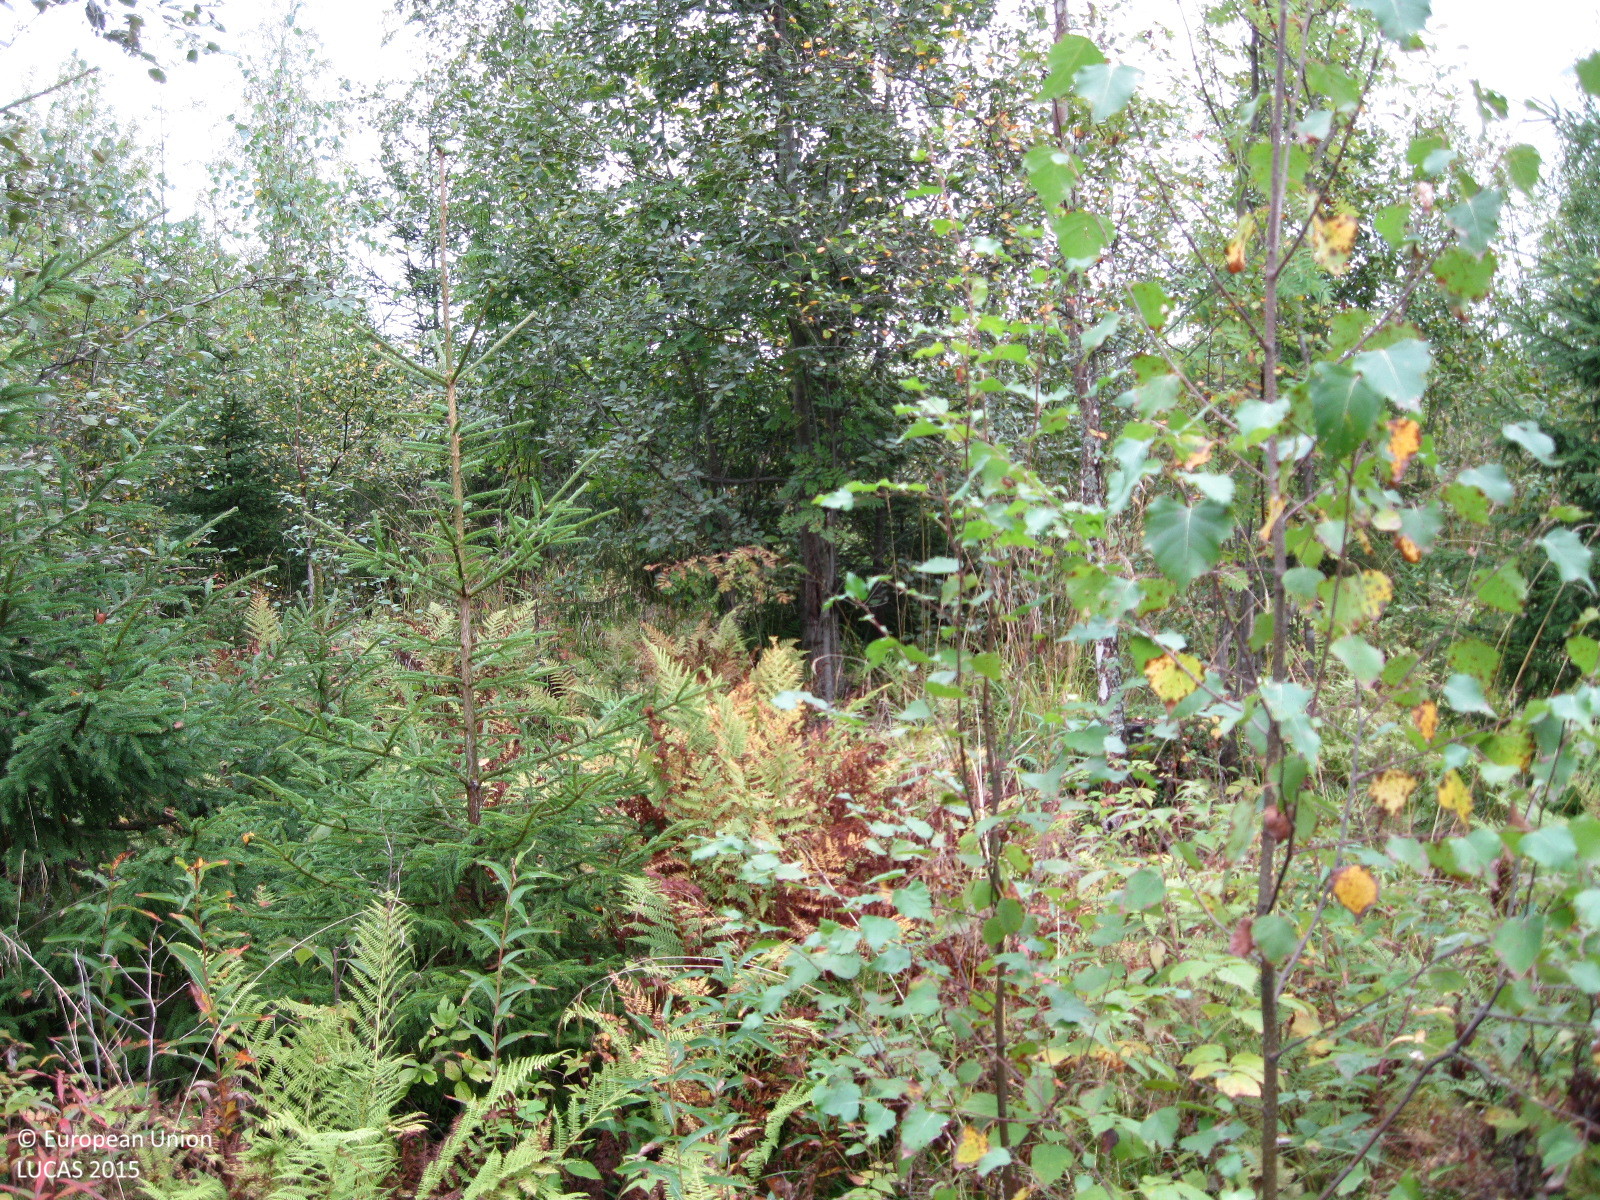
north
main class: Woodland
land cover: Broadleaved woodland
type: boreal forest
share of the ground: > 75 %
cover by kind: broadleaved forest trees 65 %, herbaceous plants 15 %, coniferous forest trees 10 %, shrubs 10 %
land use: Forestry
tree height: > 5 m
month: September
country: FI
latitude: 60.4816
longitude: 24.7592
